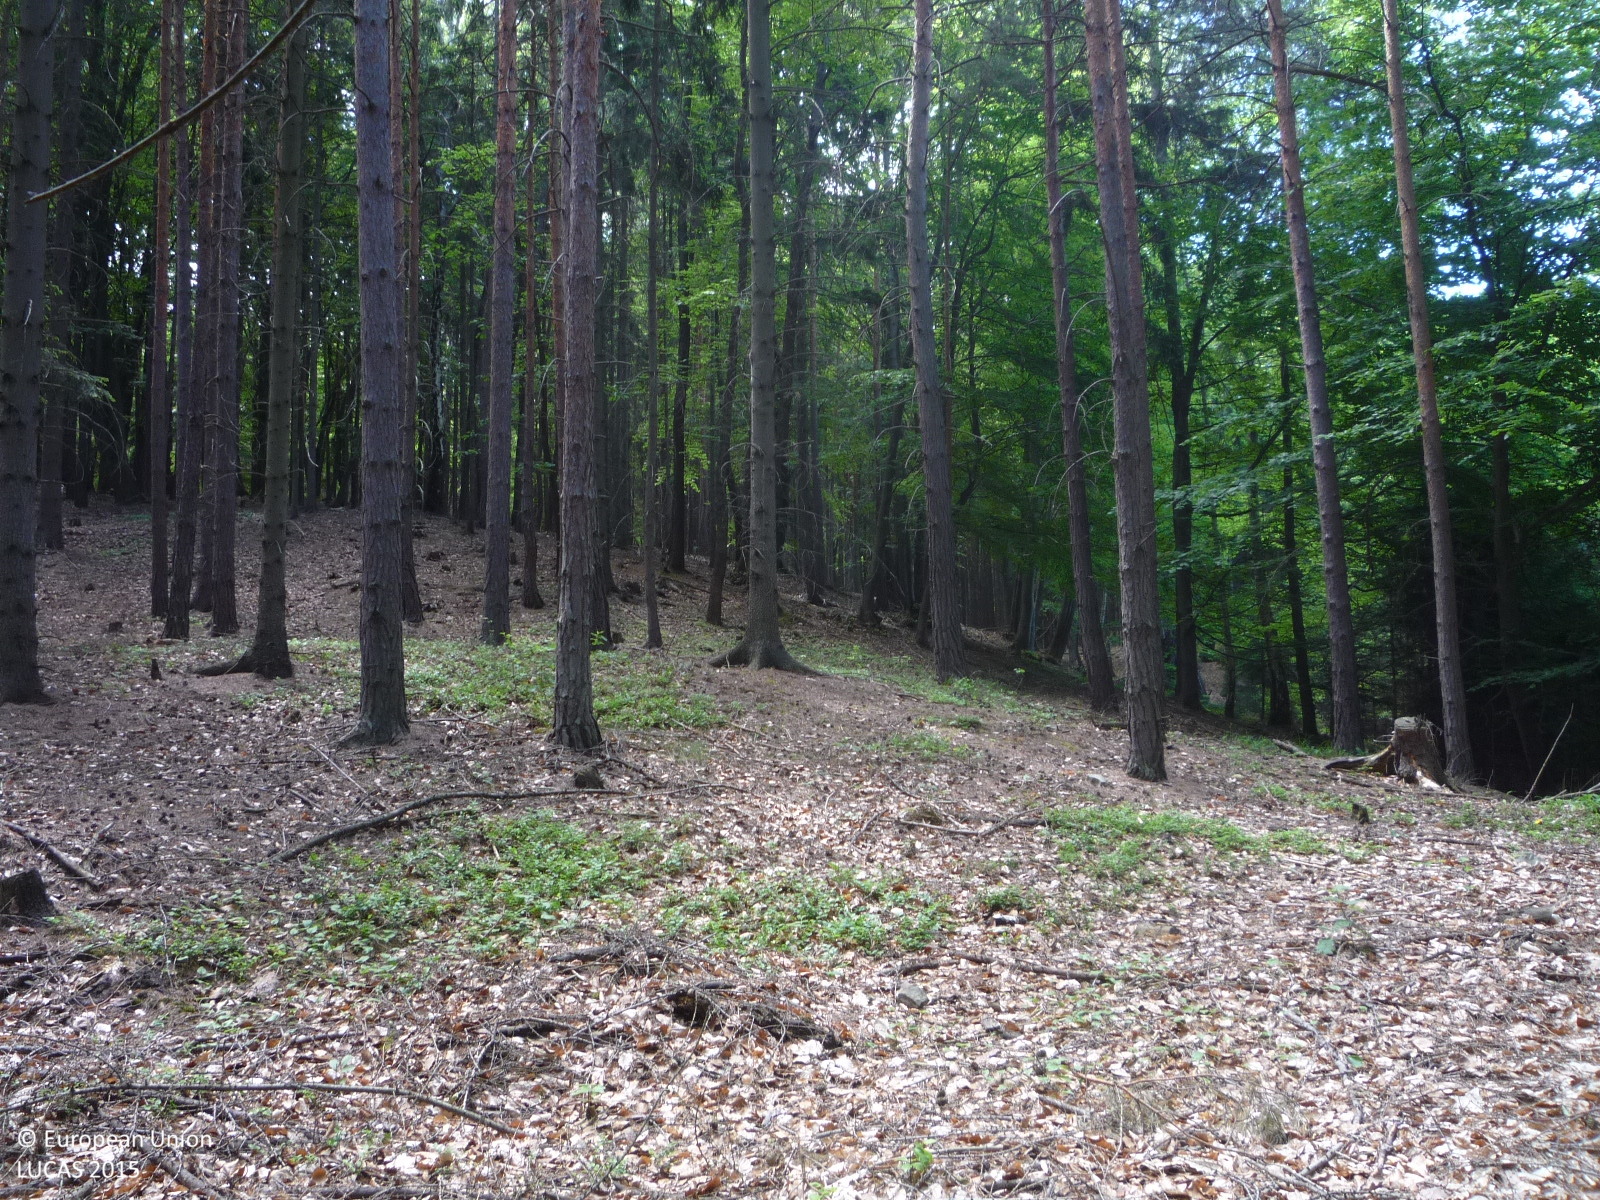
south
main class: Woodland
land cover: Other mixed woodland
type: hemiboreal forest and nemoral coniferous forest and mixed broadleaved-coniferous forest
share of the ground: > 75 %
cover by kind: coniferous forest trees 60 %, broadleaved forest trees 30 %, herbaceous plants 5 %, unconsolidated bare surface 5 %
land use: Forestry
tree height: > 5 m
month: June
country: CZ
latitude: 50.2092
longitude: 13.8541
